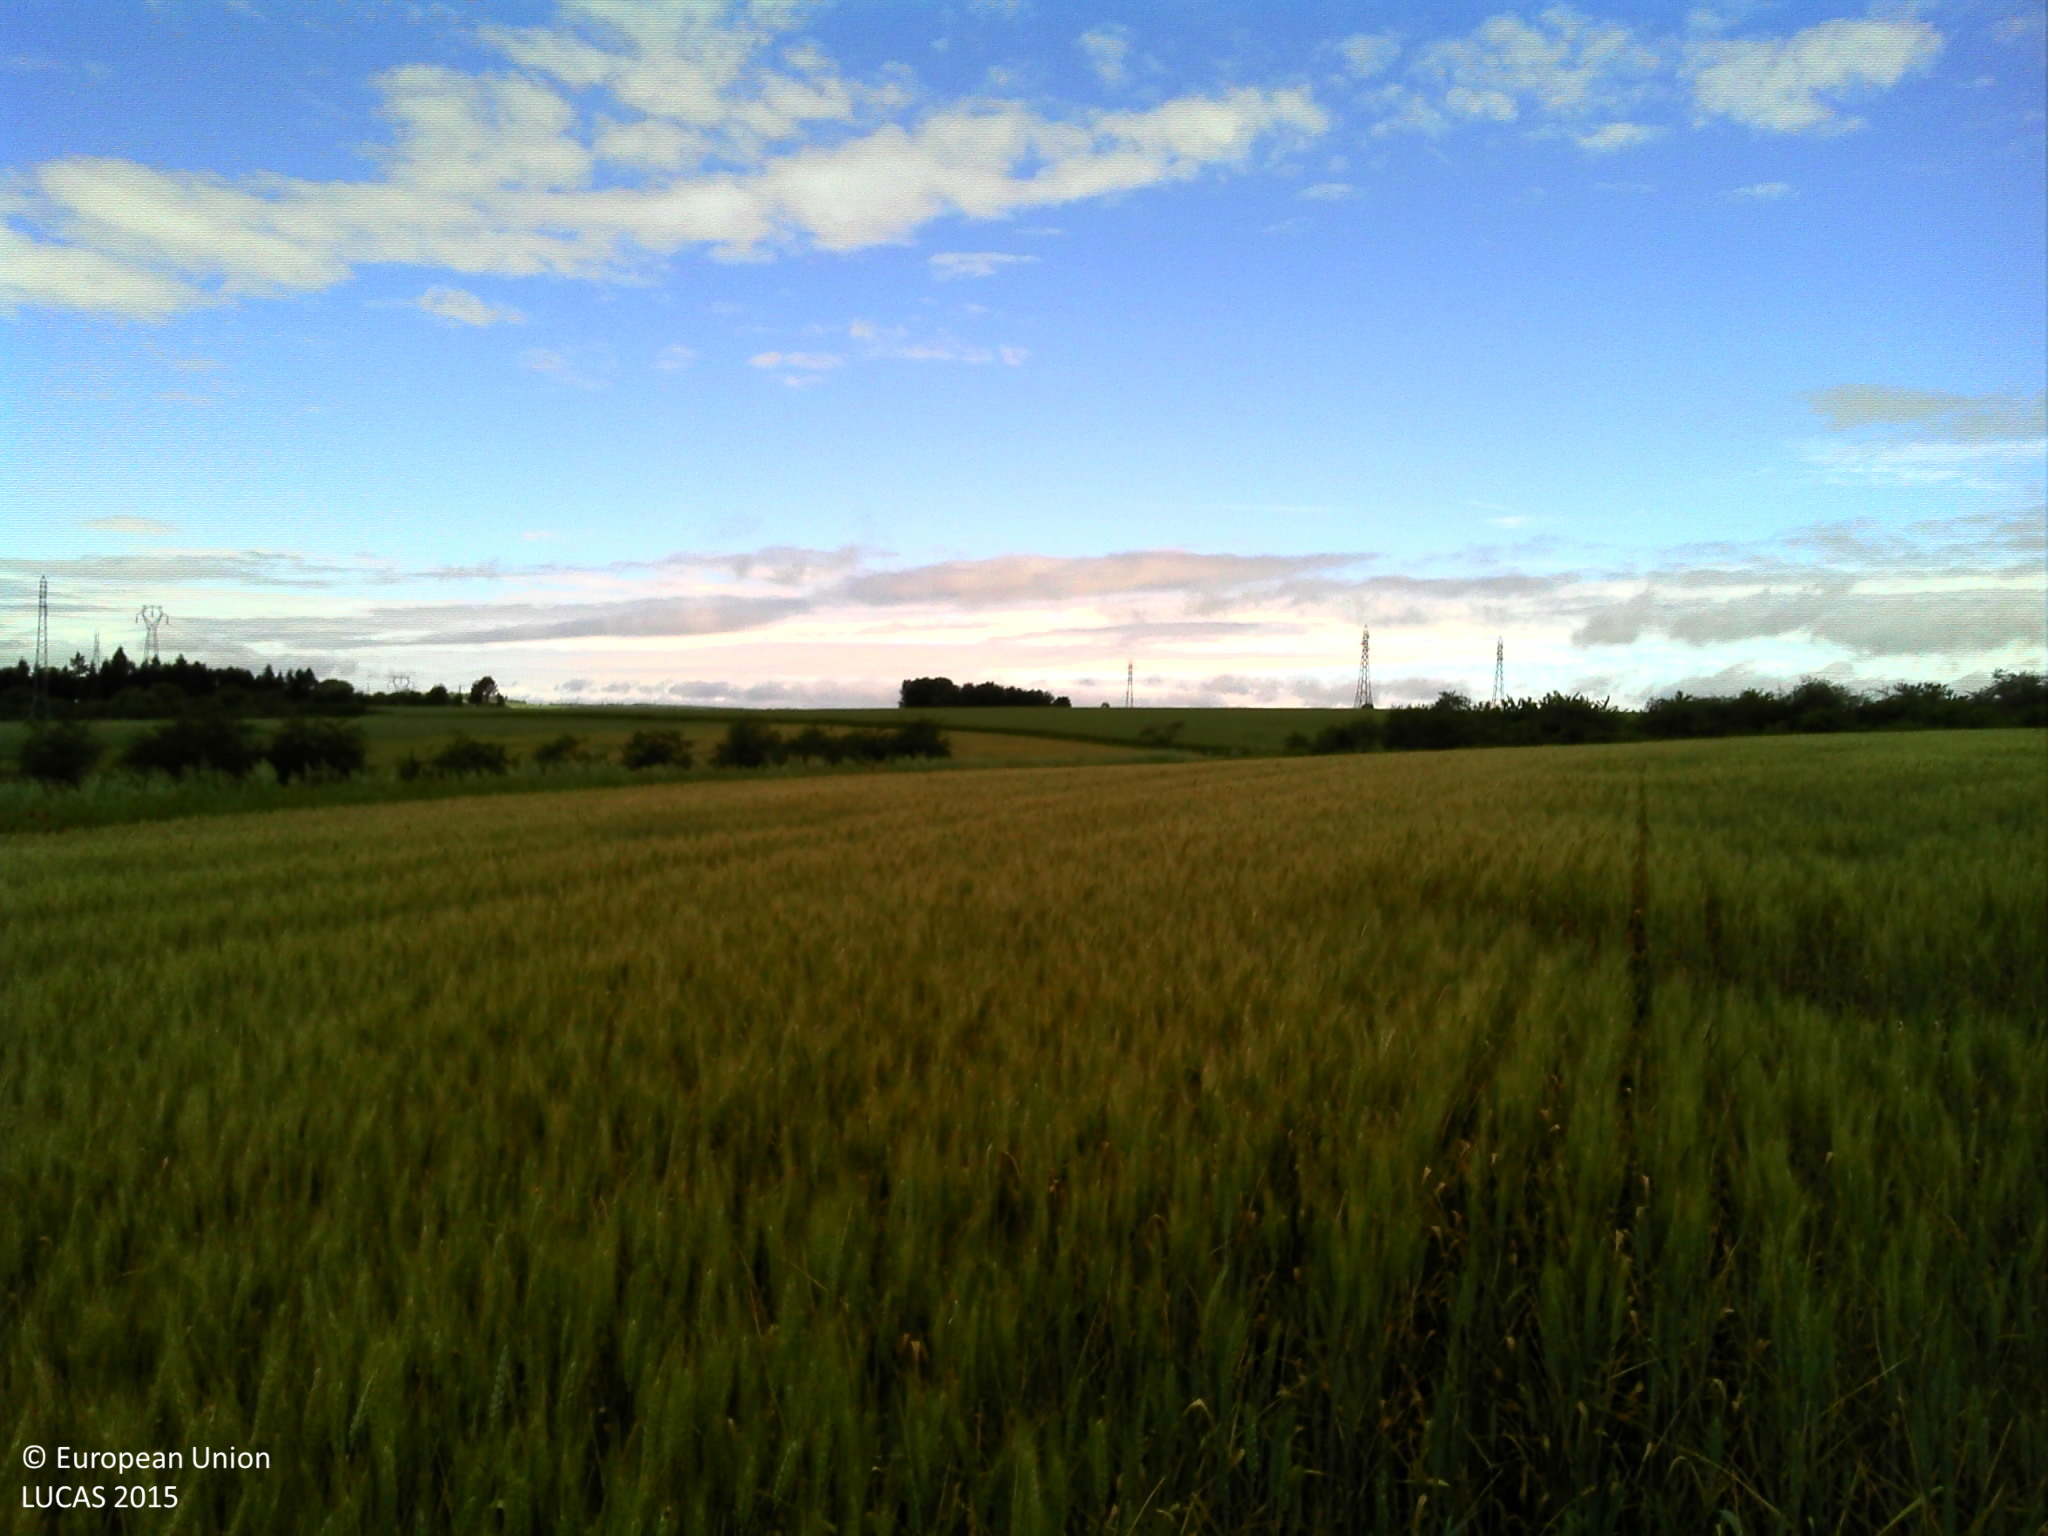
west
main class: Cropland
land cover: Durum wheat
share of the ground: > 75 %
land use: Agriculture (excluding fallow land and kitchen gardens)
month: June
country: FR
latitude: 47.3736
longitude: 5.0606
